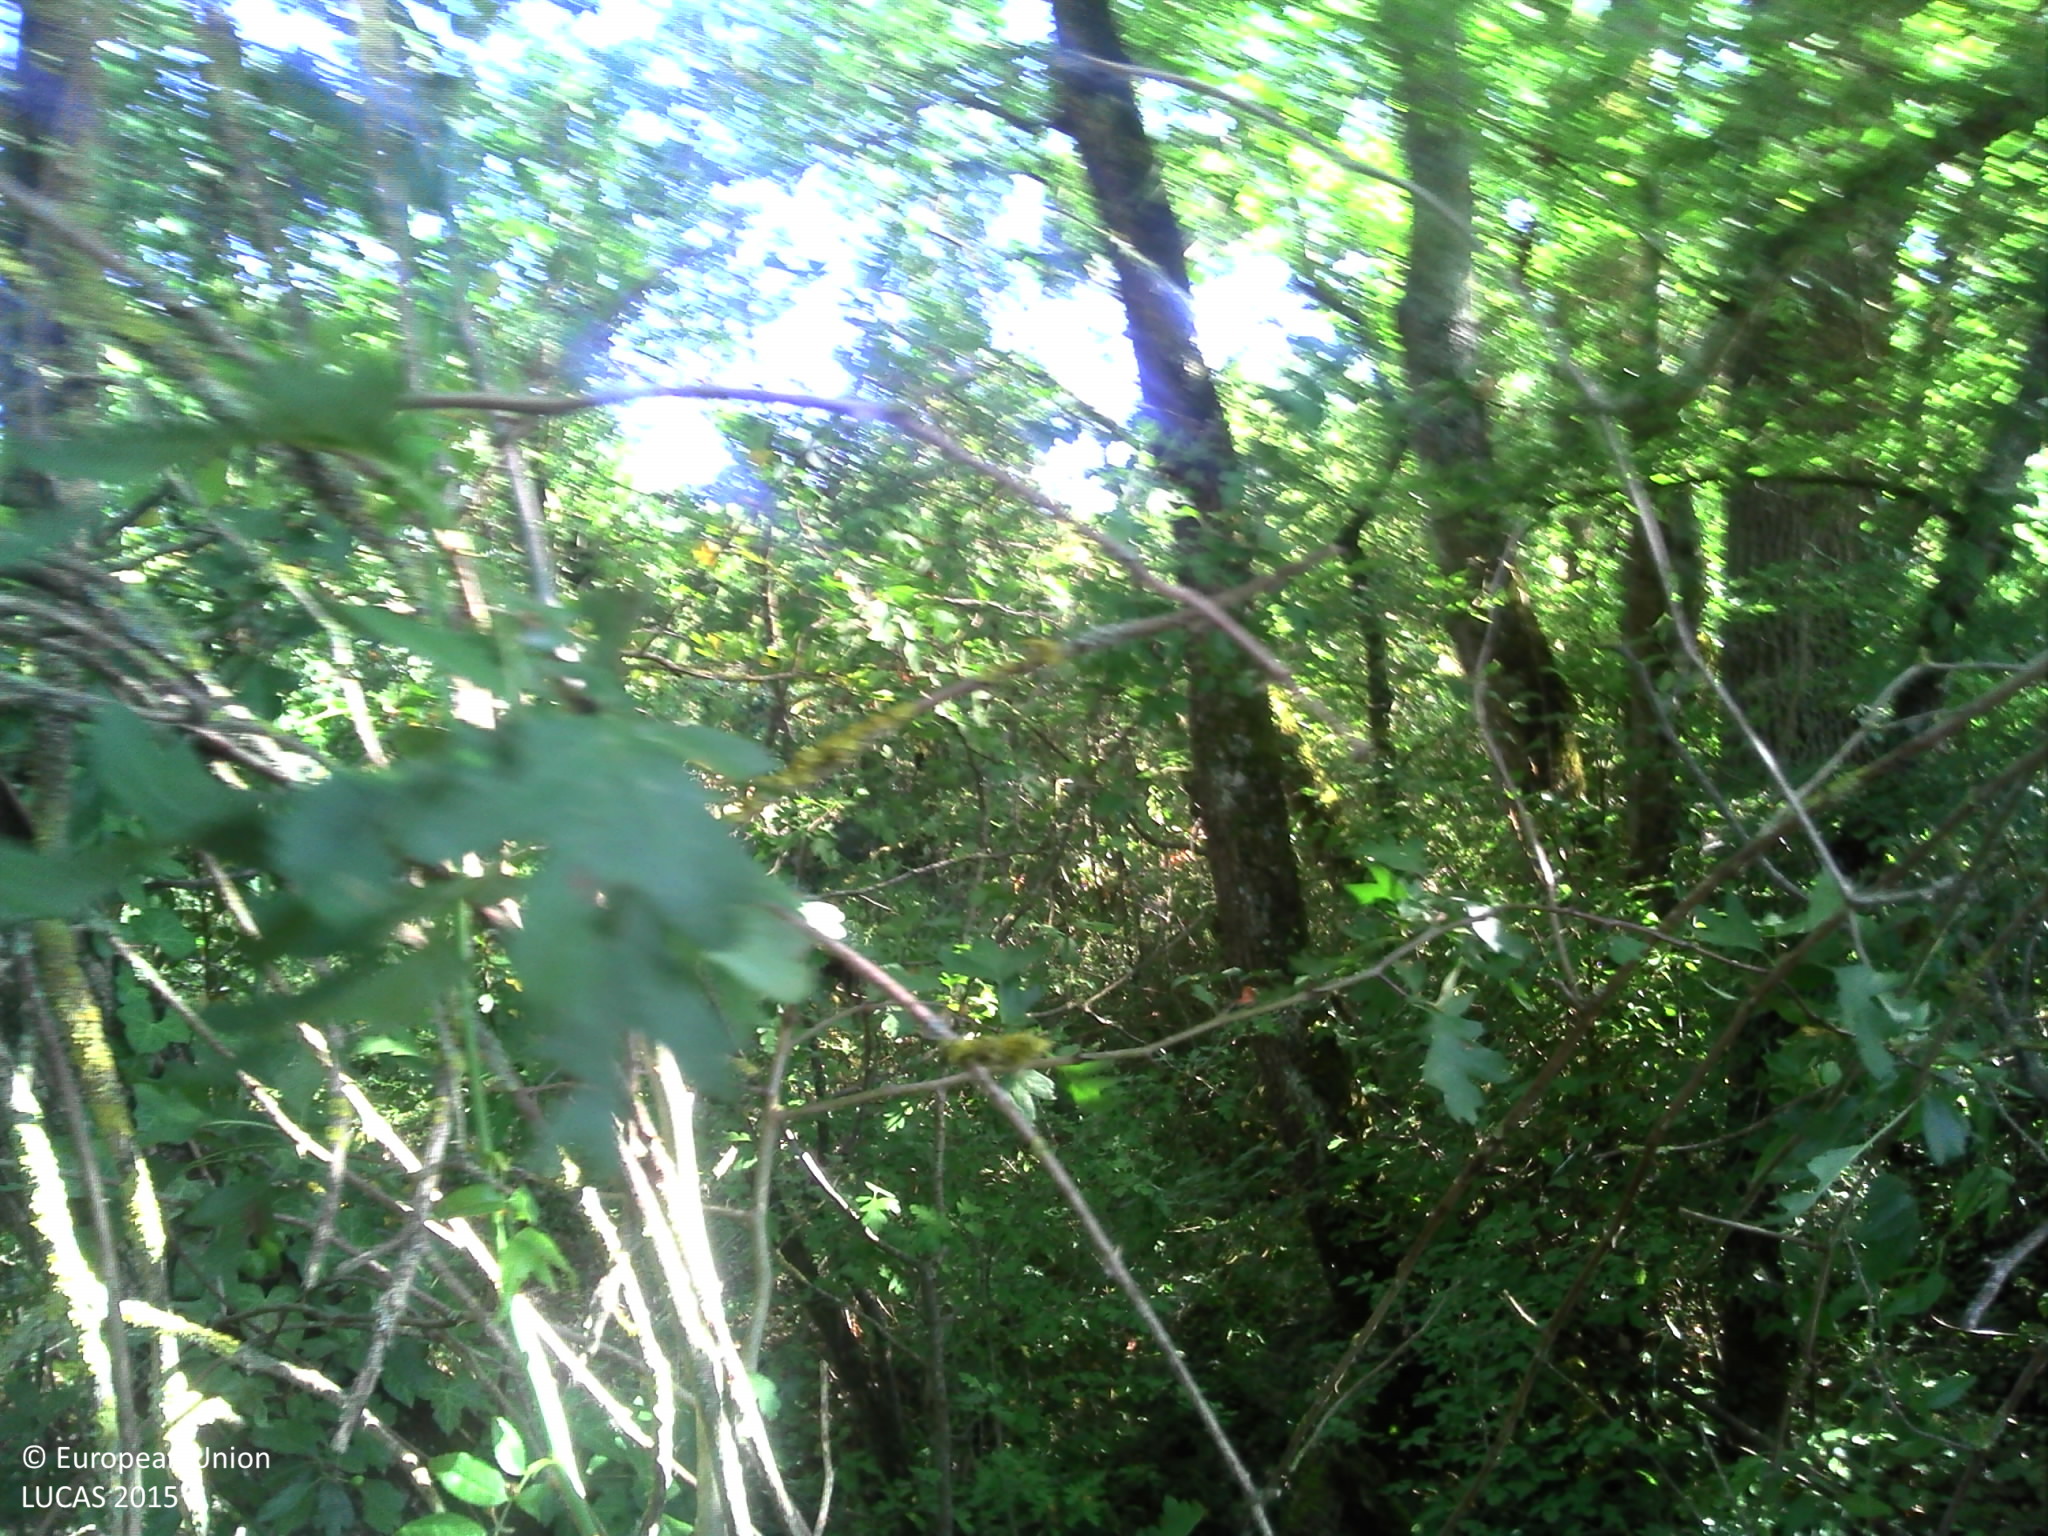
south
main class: Woodland
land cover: Broadleaved woodland
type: thermophilous deciduous forest
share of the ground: > 75 %
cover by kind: broadleaved forest trees 80 %, shrubs 10 %, herbaceous plants 10 %
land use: Forestry
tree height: > 5 m
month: July
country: FR
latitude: 43.8442
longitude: 0.7308
